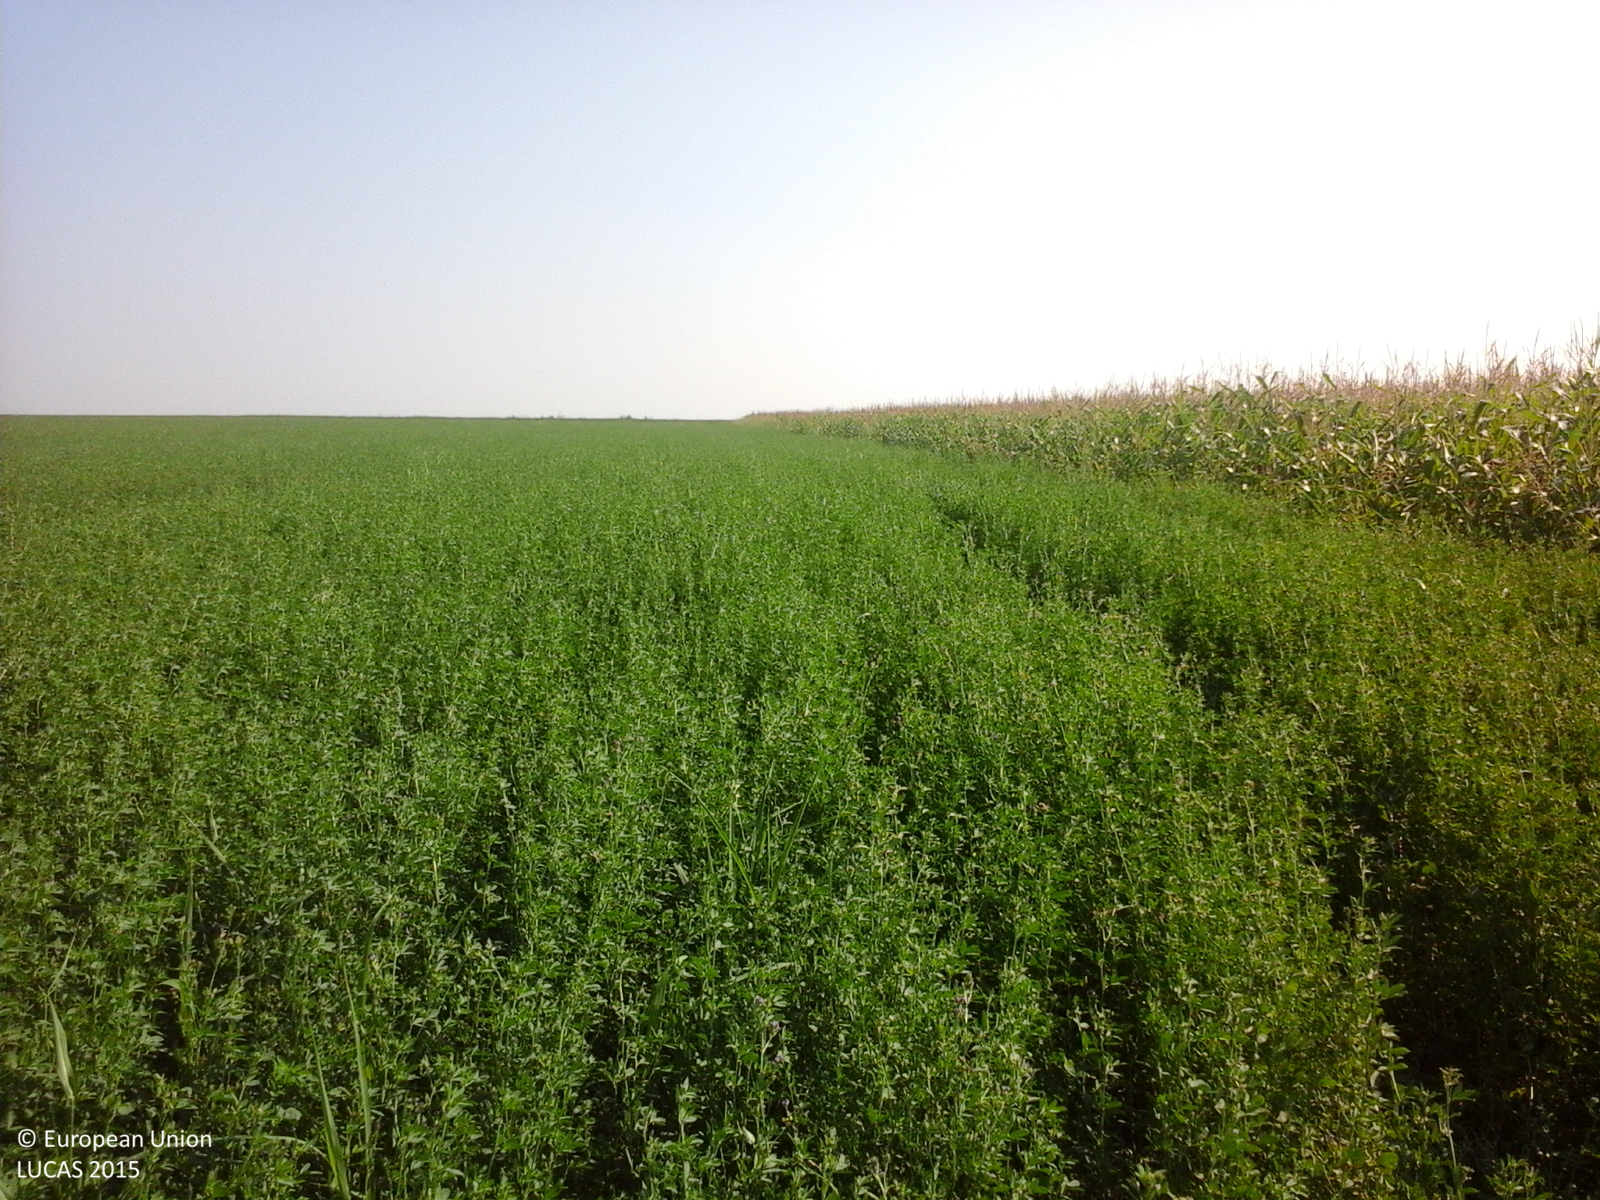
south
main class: Cropland
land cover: Lucerne
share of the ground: > 75 %
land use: Agriculture (excluding fallow land and kitchen gardens)
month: July
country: RO
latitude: 44.7080
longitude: 27.2925
